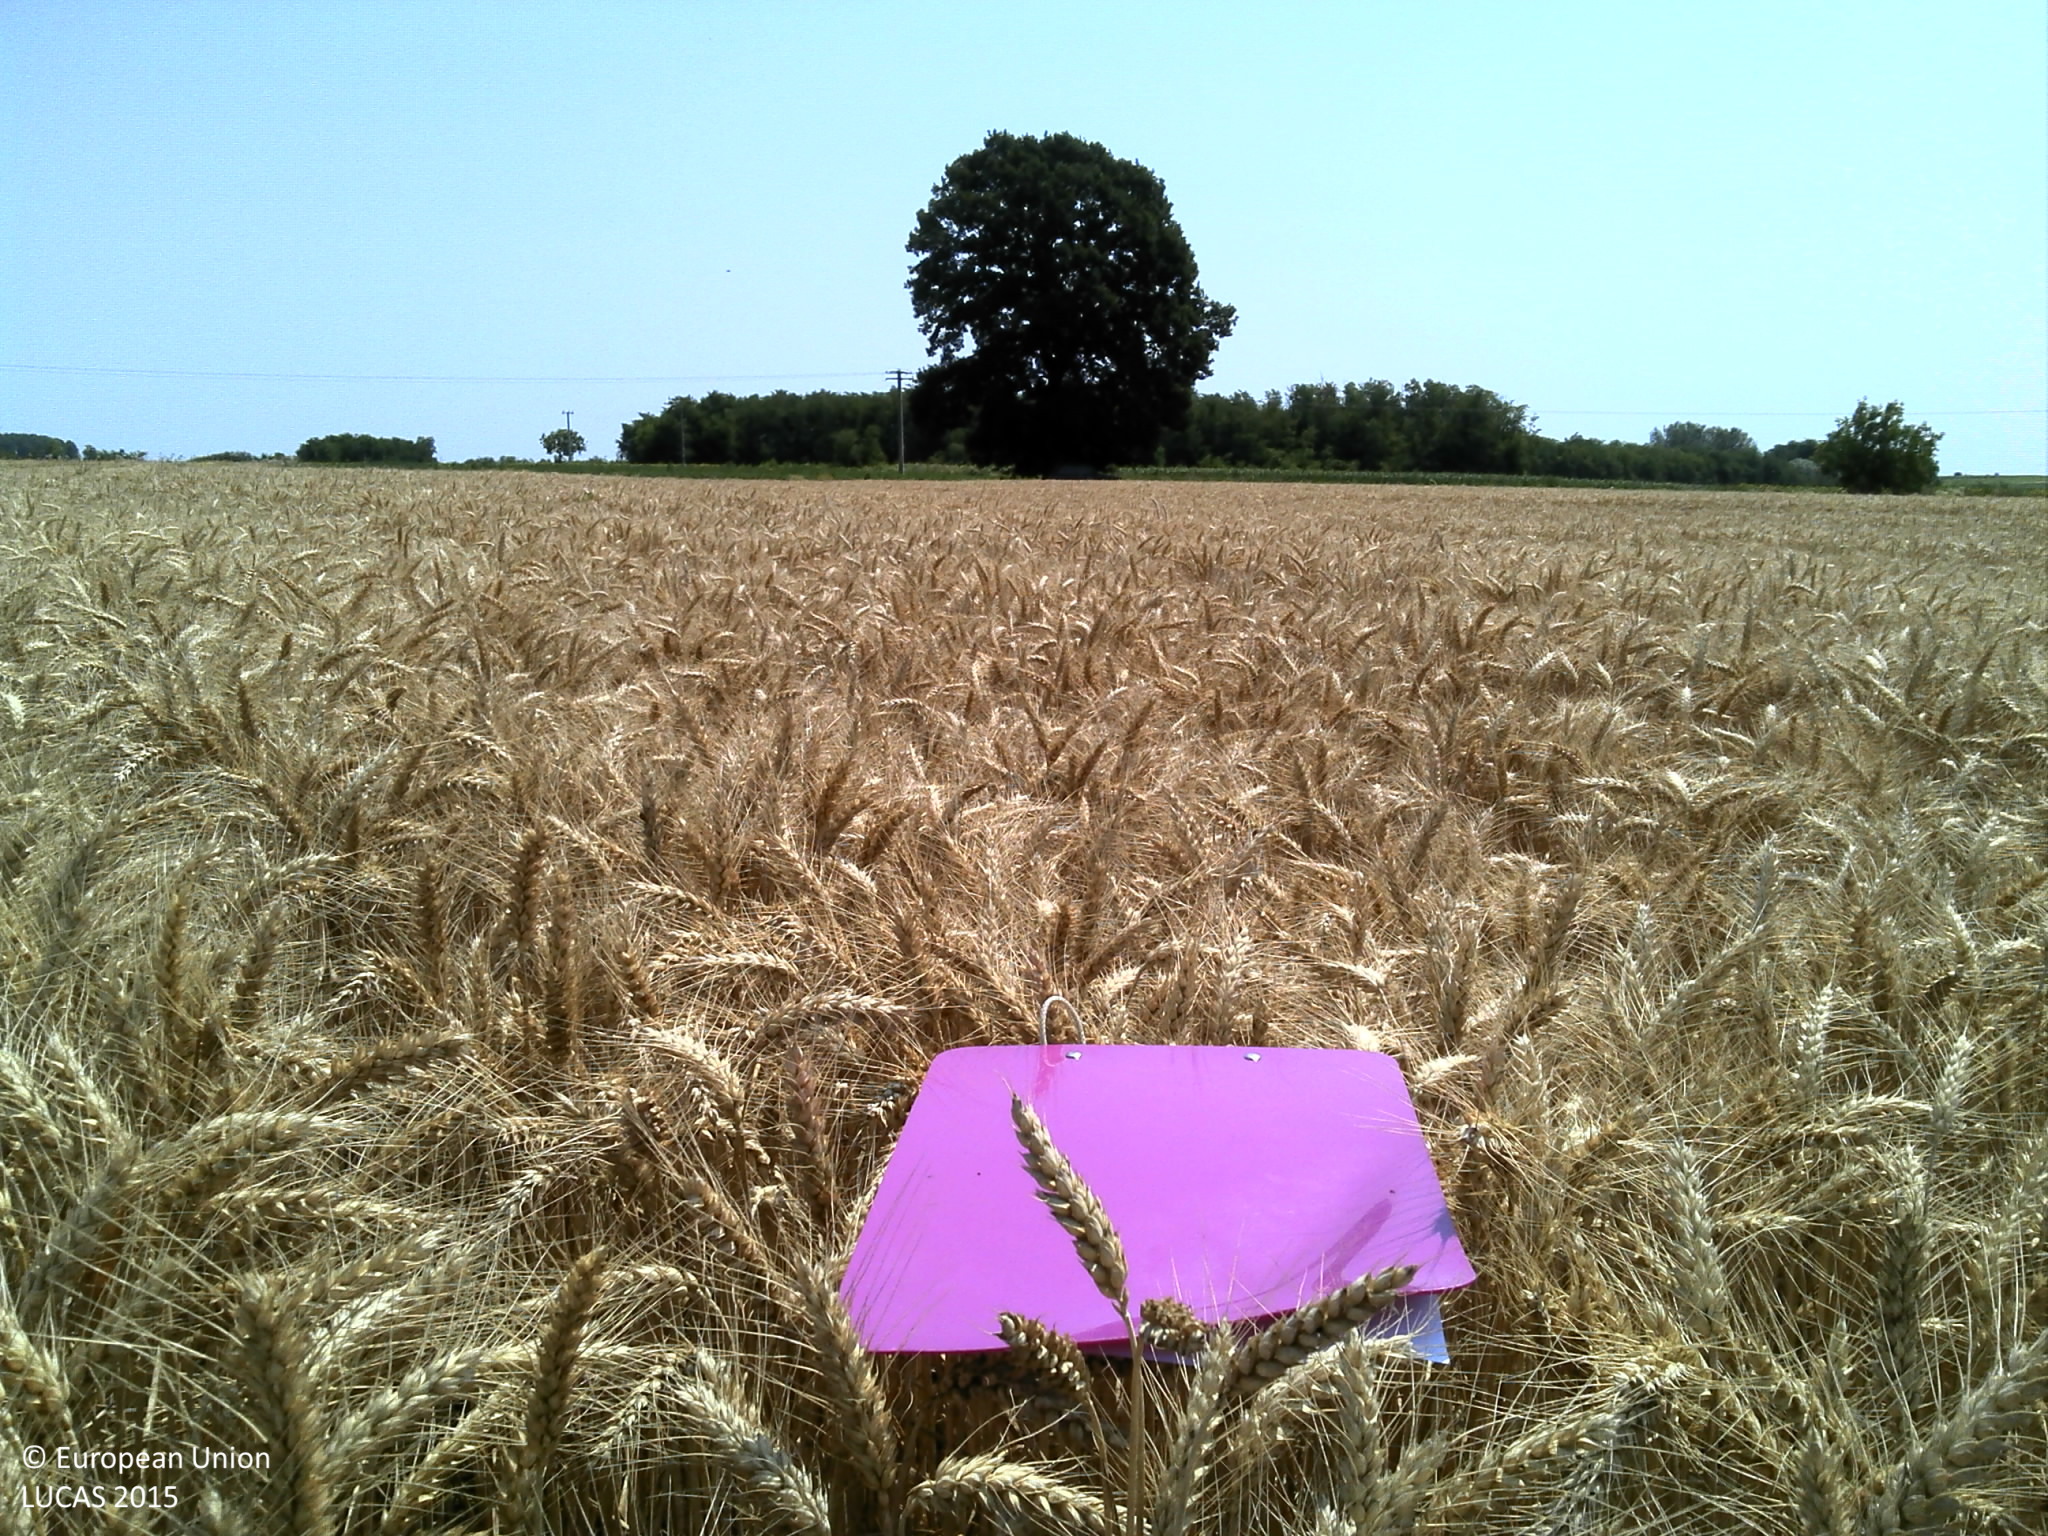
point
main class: Cropland
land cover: Common wheat
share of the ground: > 75 %
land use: Agriculture (excluding fallow land and kitchen gardens)
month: July
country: HR
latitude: 45.3010
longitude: 18.5630
